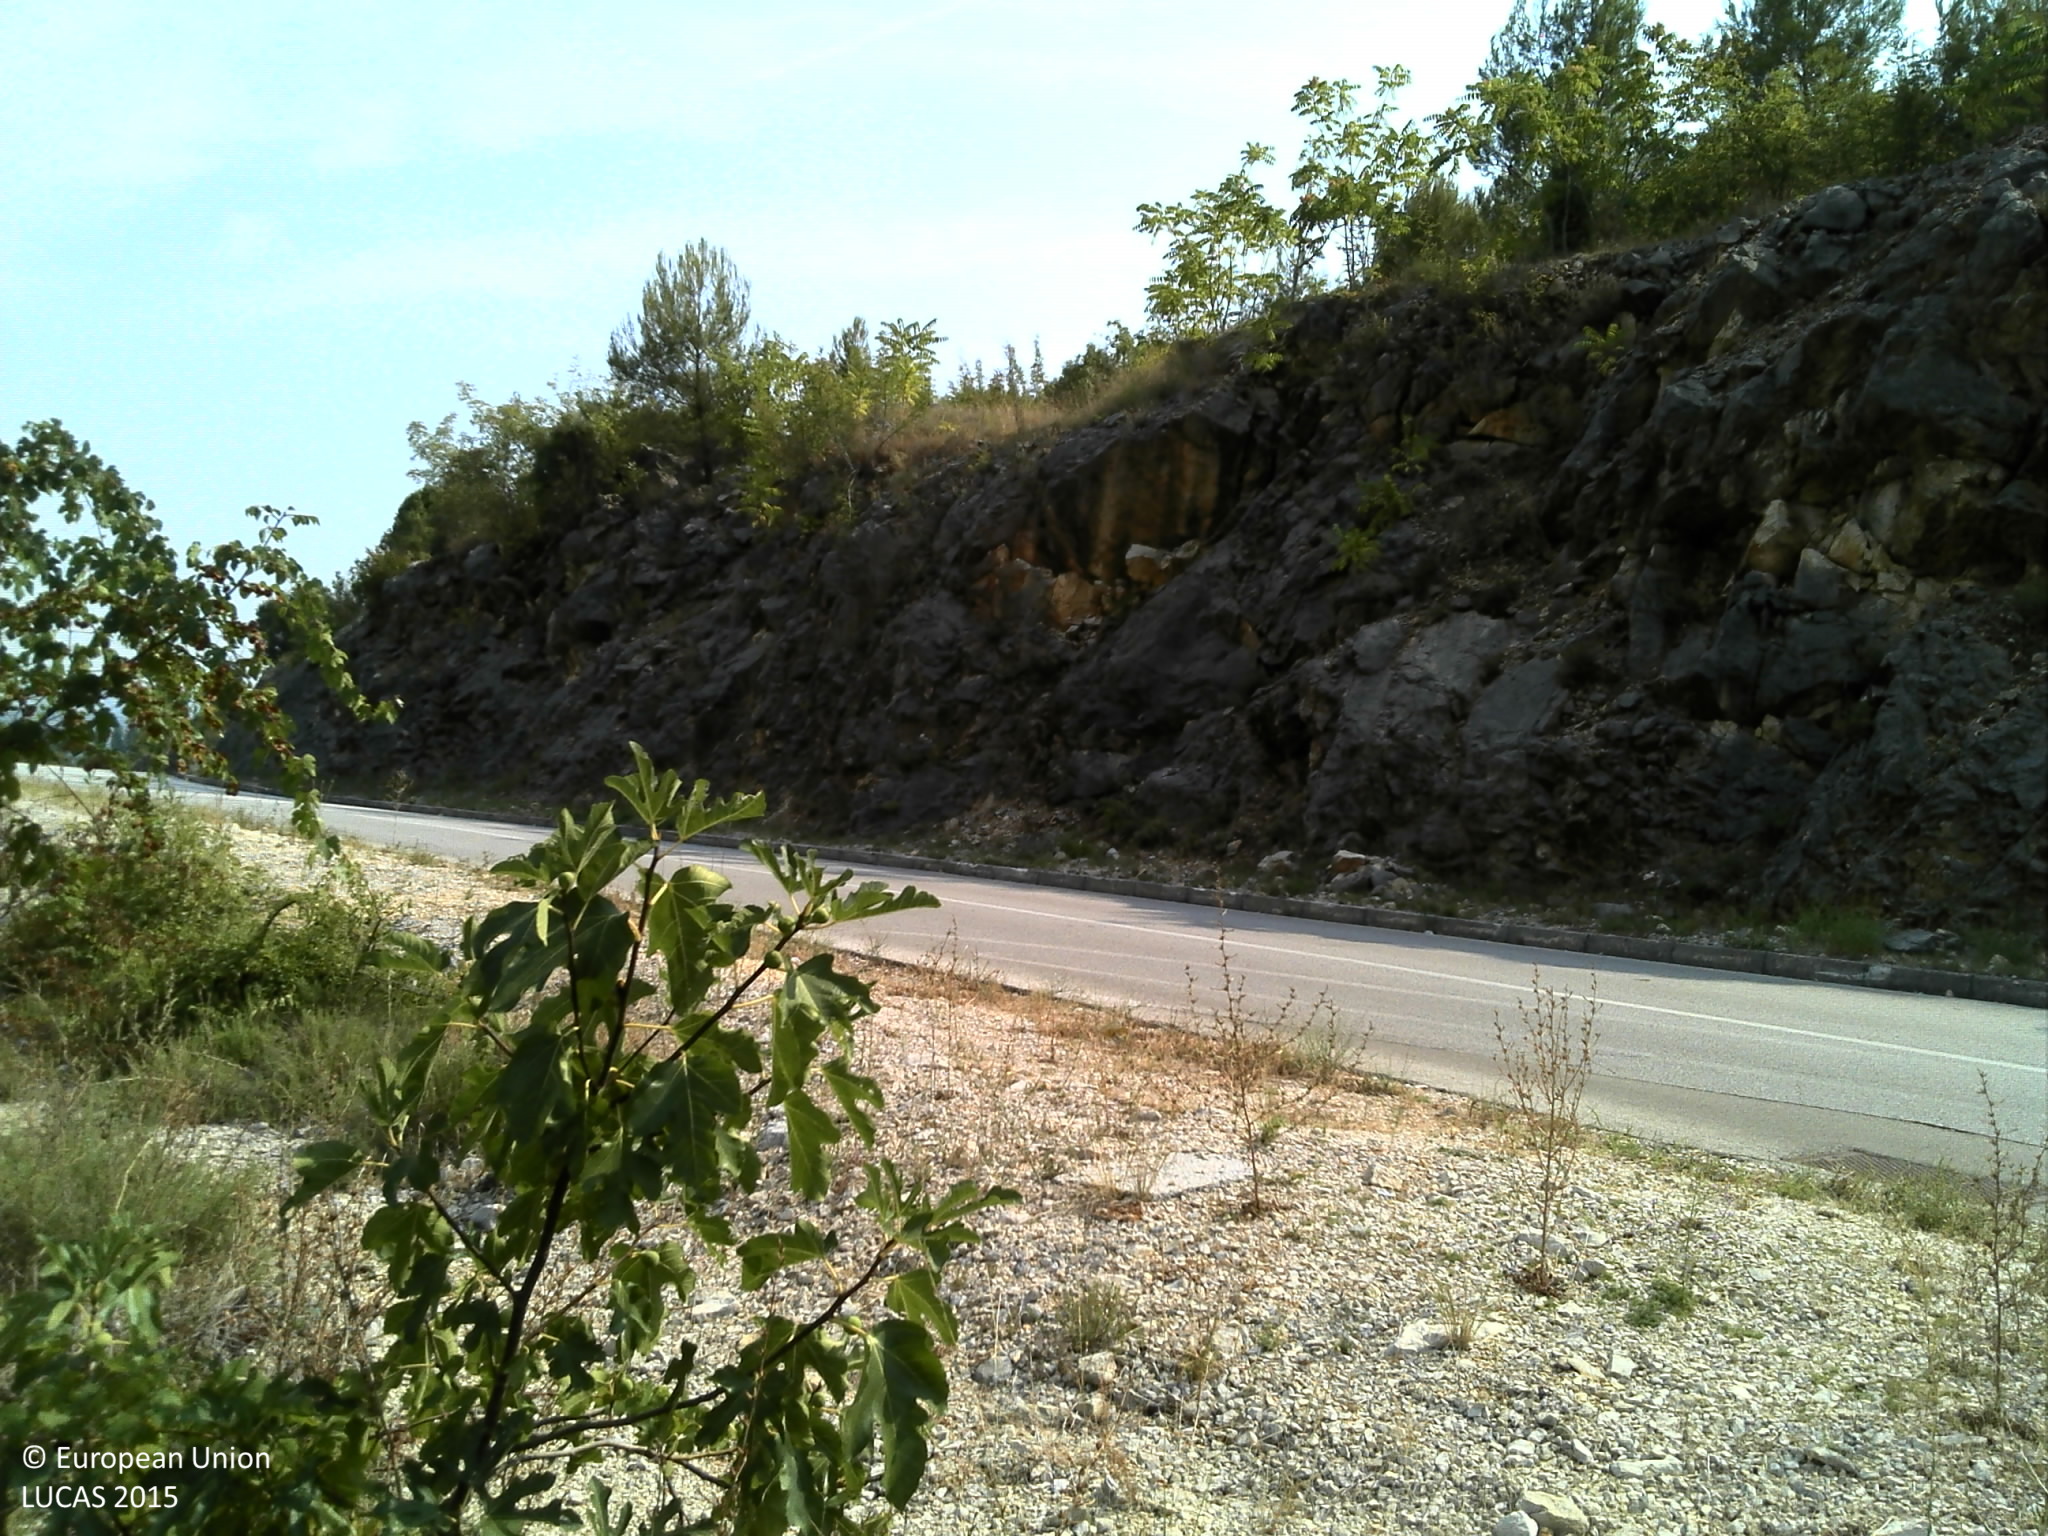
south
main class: Cropland
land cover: Other fruit trees and berries
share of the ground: 50 - 75 %
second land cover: Spontaneously vegetated surfaces
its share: > 75 %
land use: Agriculture (excluding fallow land and kitchen gardens)
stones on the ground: > 50 %
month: August
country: HR
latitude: 43.0918
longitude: 17.6202
